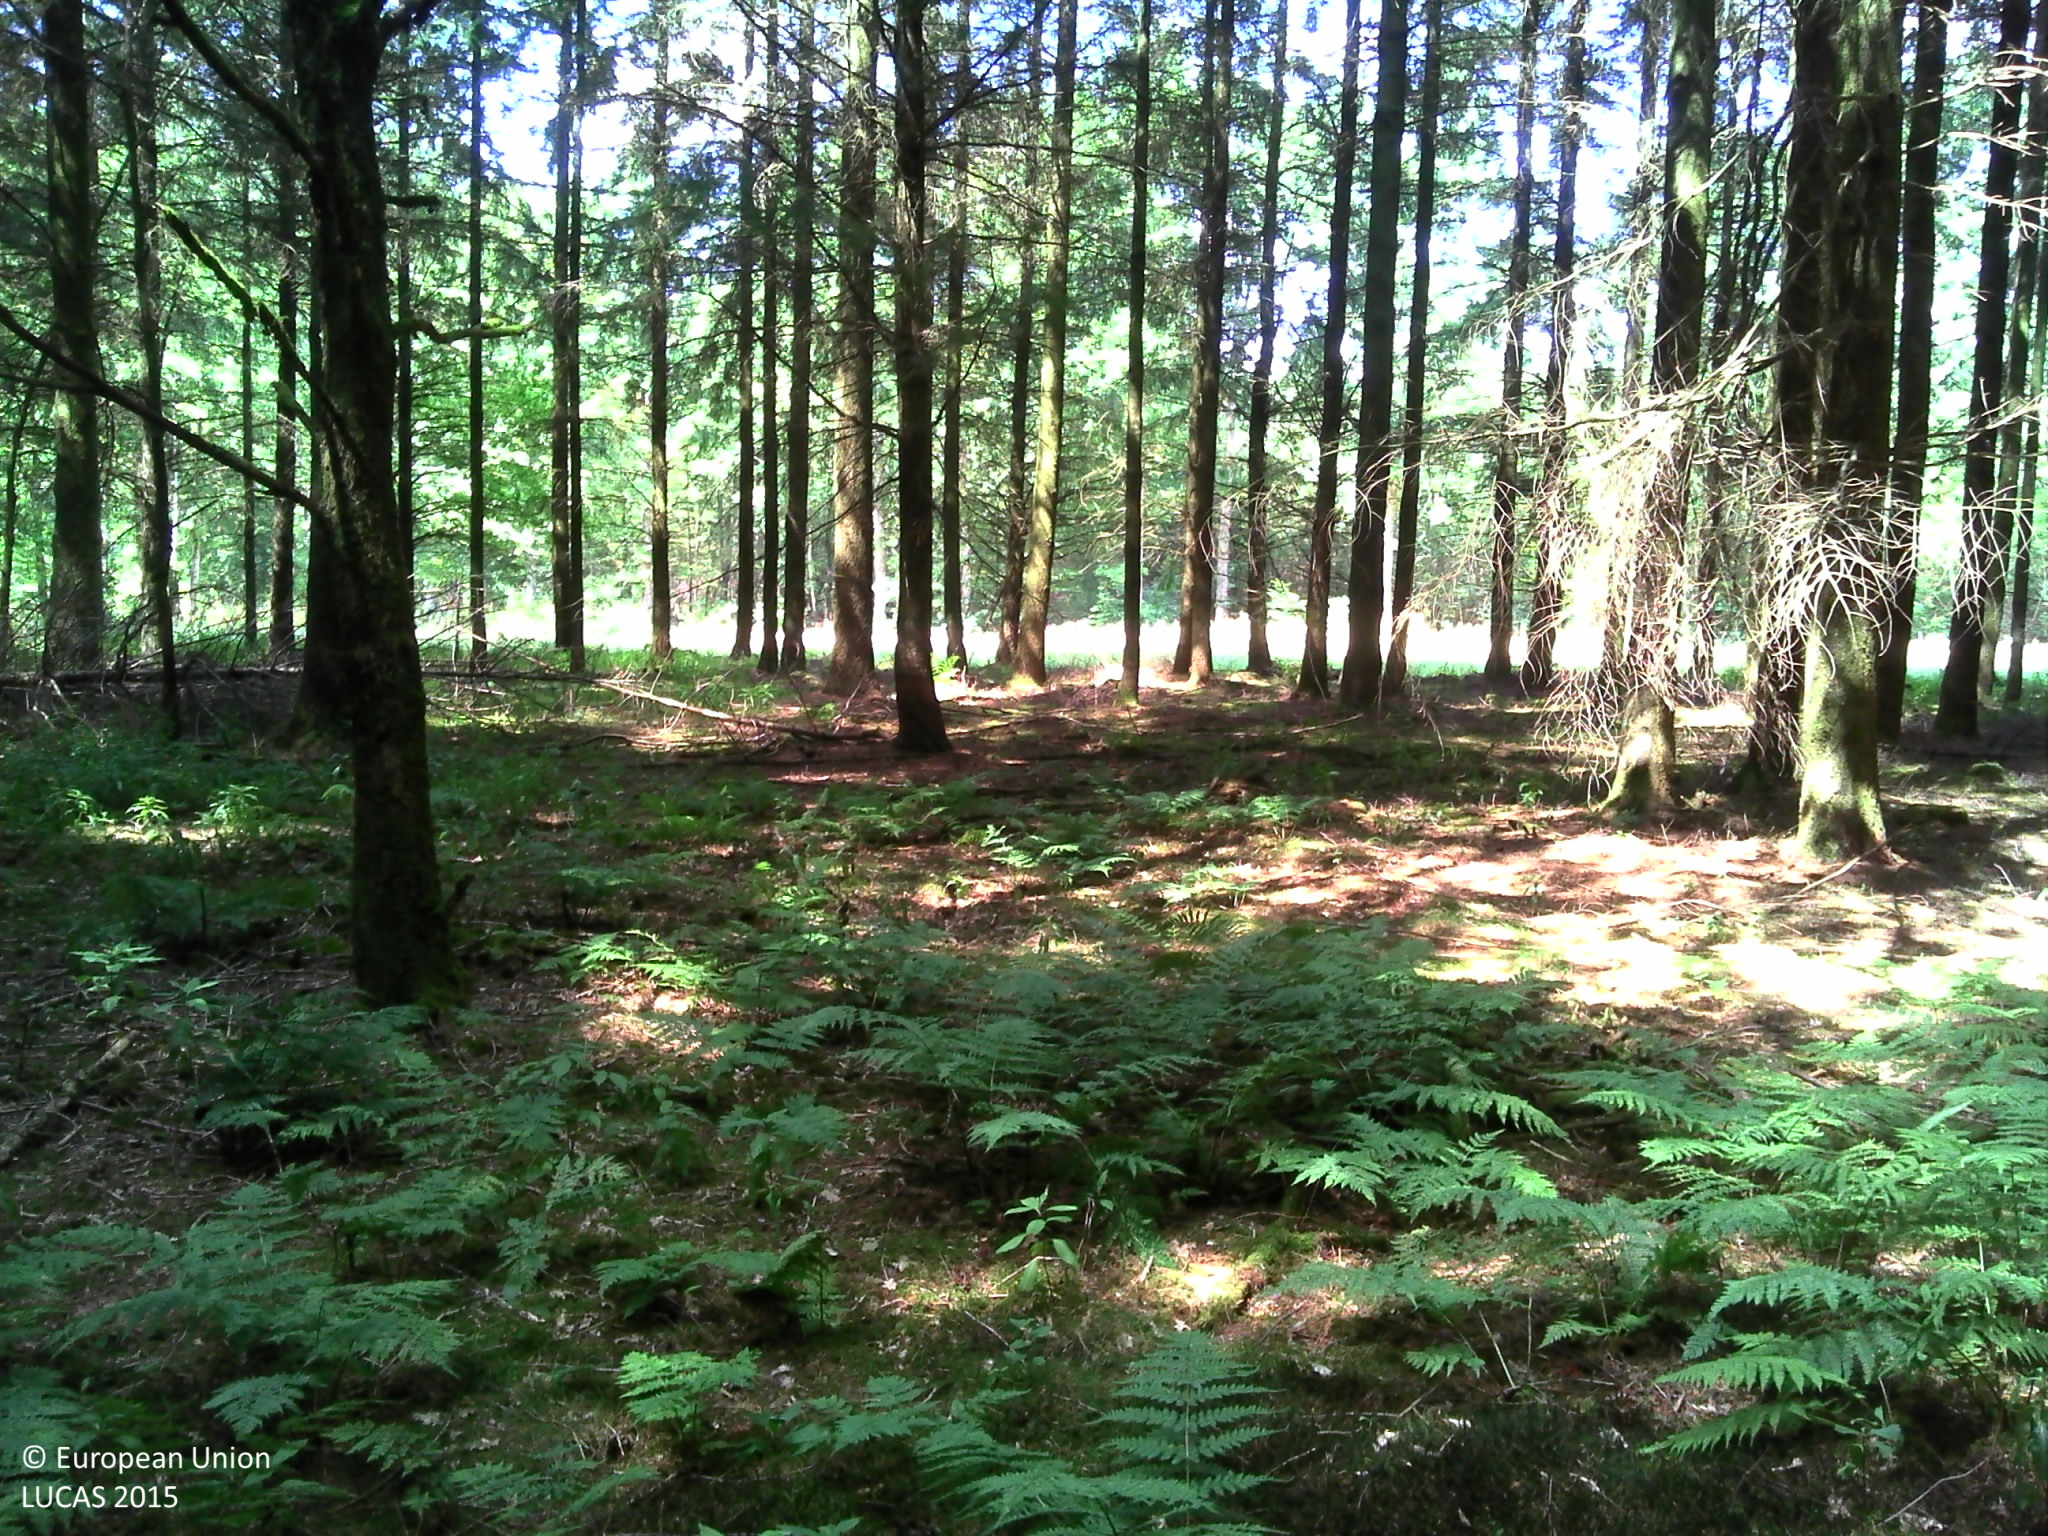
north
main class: Woodland
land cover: Other coniferous woodland
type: exotic forest
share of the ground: > 75 %
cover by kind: coniferous forest trees 95 %, herbaceous plants 5 %
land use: Forestry
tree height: > 5 m
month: July
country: BE
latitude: 49.8880
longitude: 5.7257
